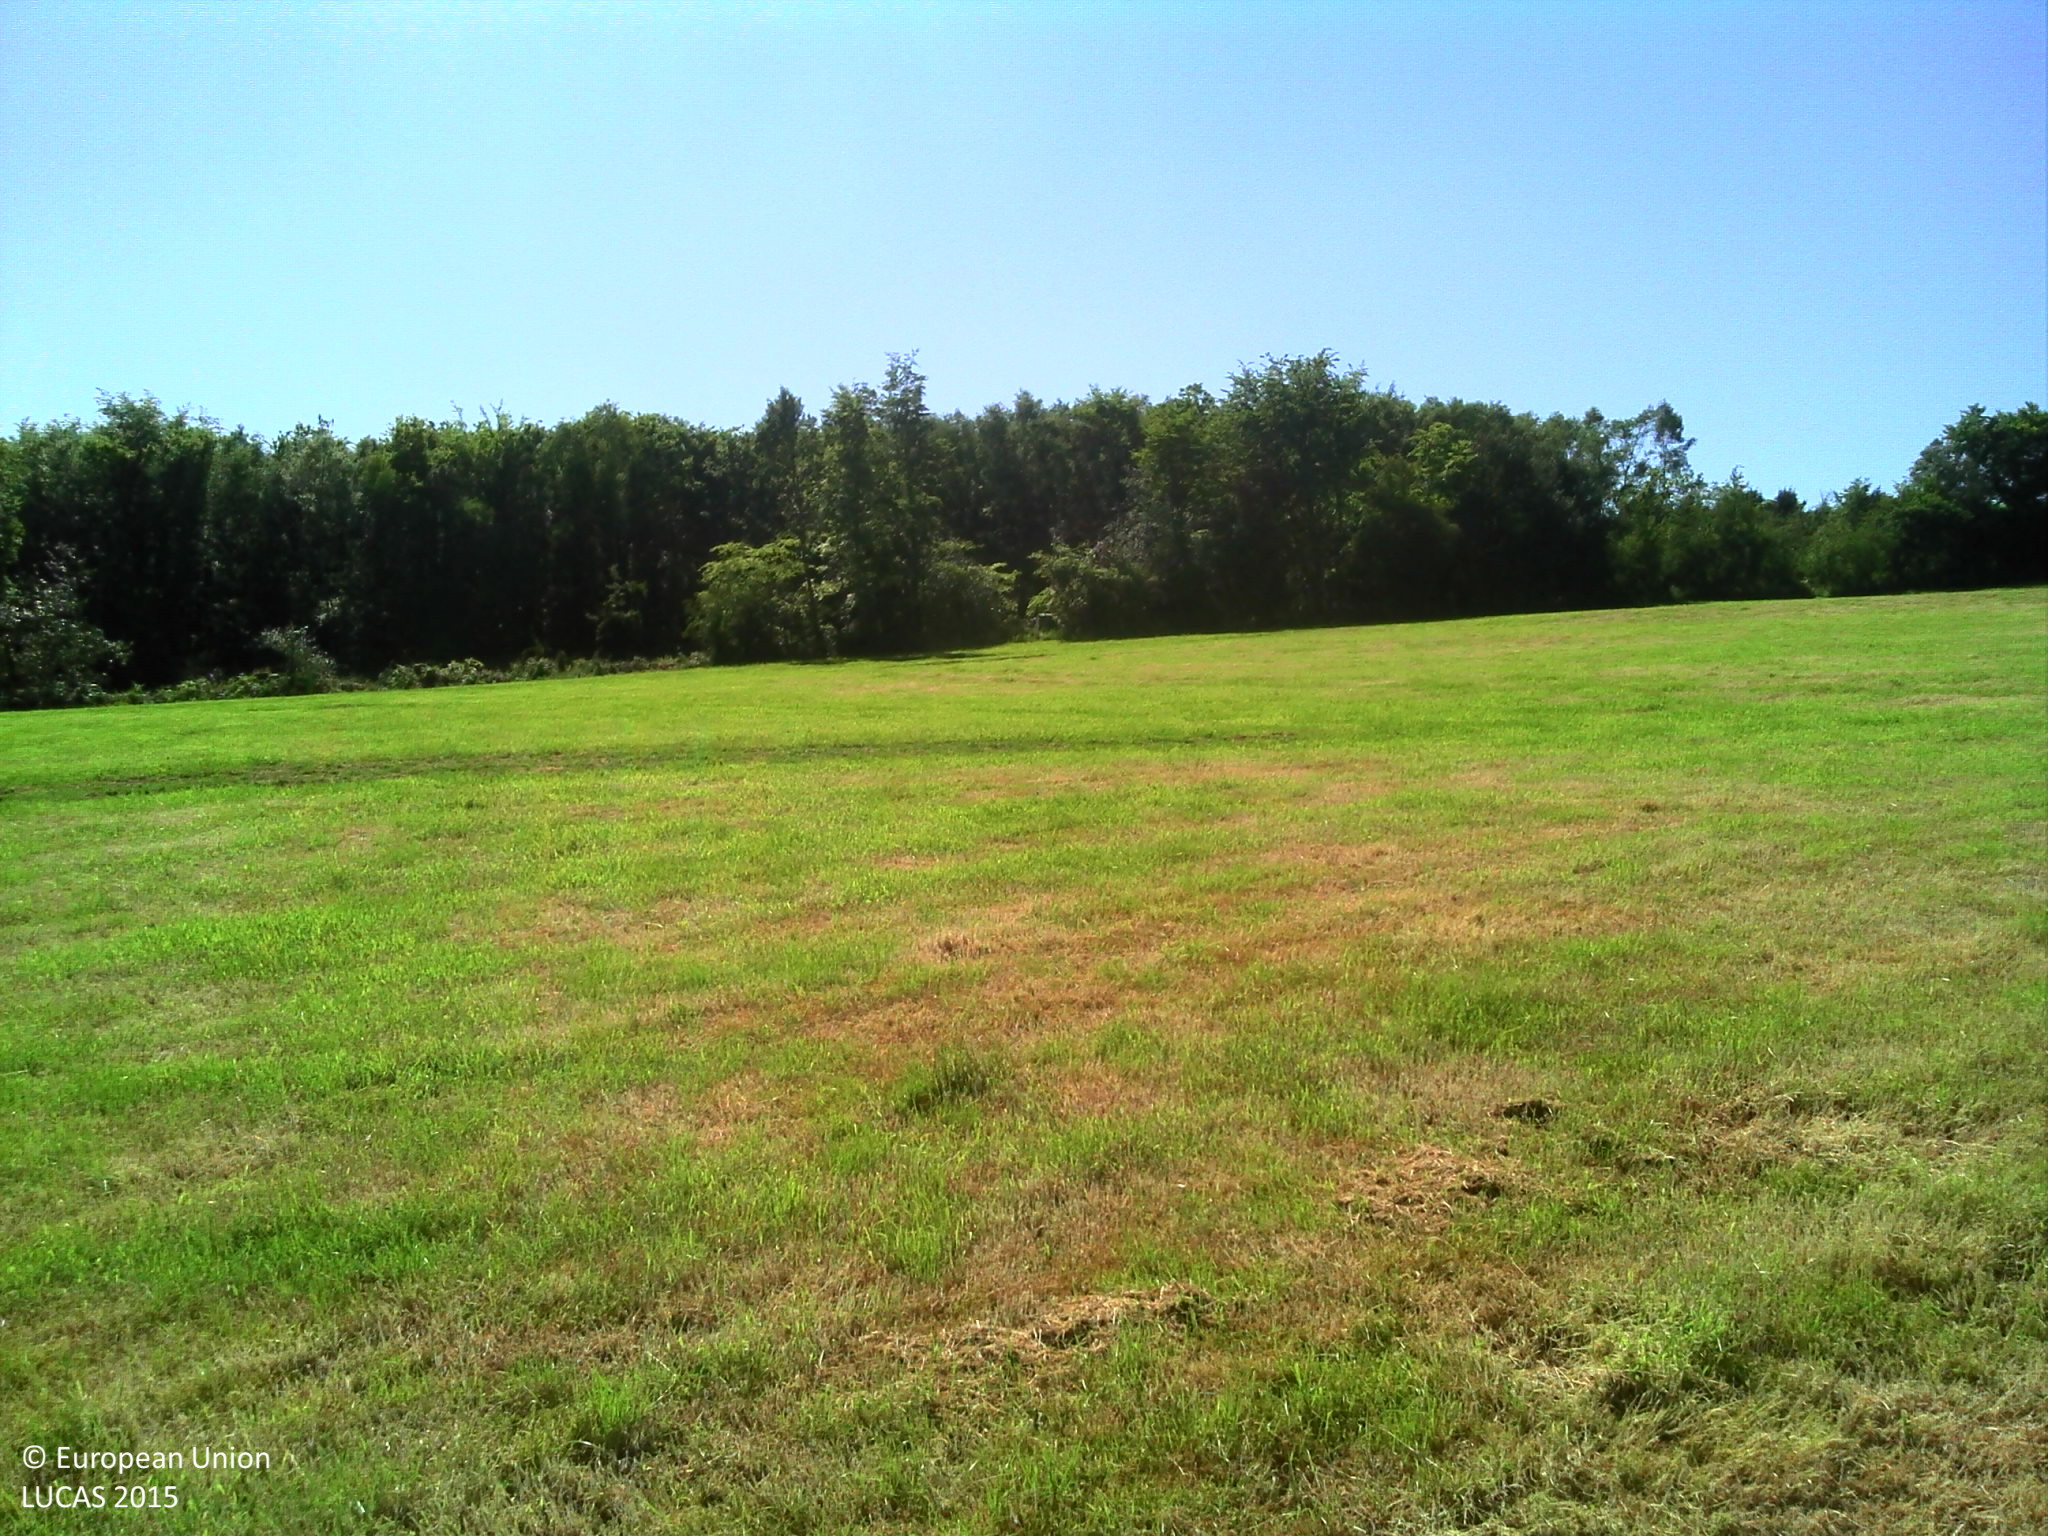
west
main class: Grassland
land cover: Grassland without tree/shrub cover
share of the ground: > 75 %
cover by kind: herbaceous plants 100 %
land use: Agriculture (excluding fallow land and kitchen gardens)
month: June
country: FR
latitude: 49.4691
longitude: -1.7127
